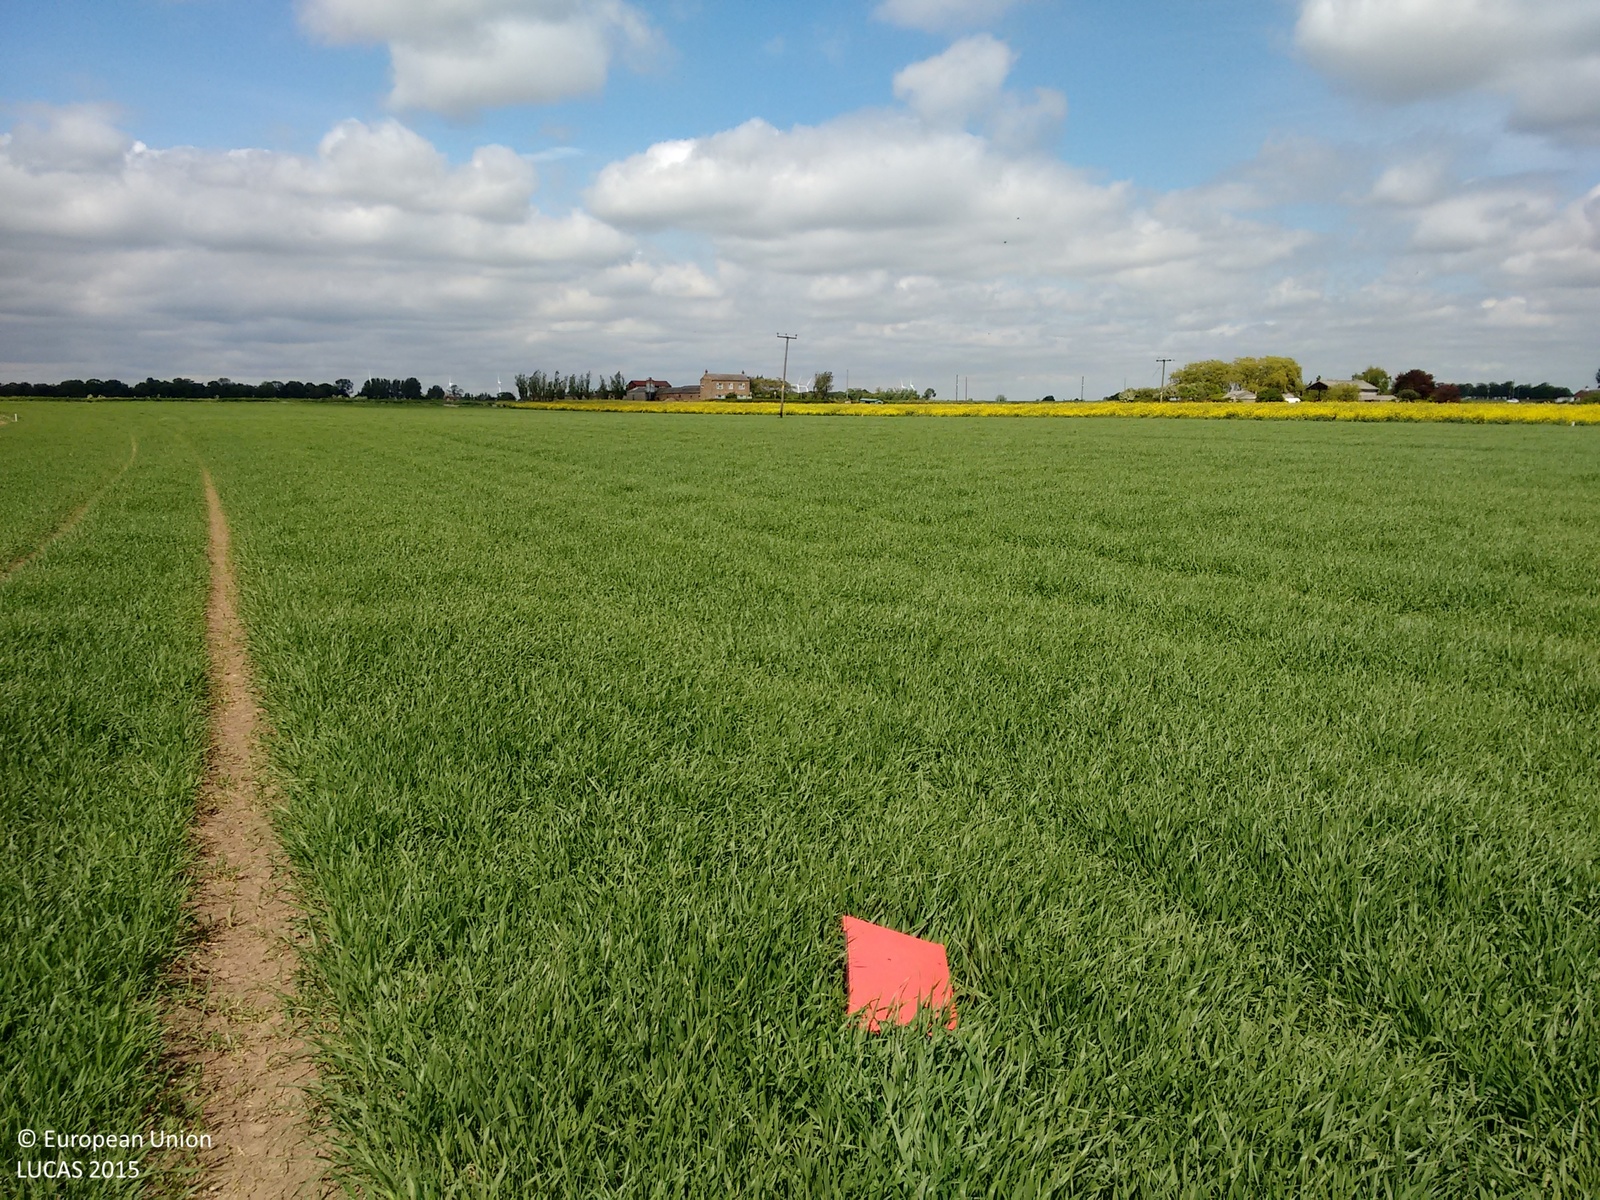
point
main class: Cropland
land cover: Barley
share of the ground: > 75 %
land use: Agriculture (excluding fallow land and kitchen gardens)
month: May
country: GB
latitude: 53.6968
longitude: -0.8093
